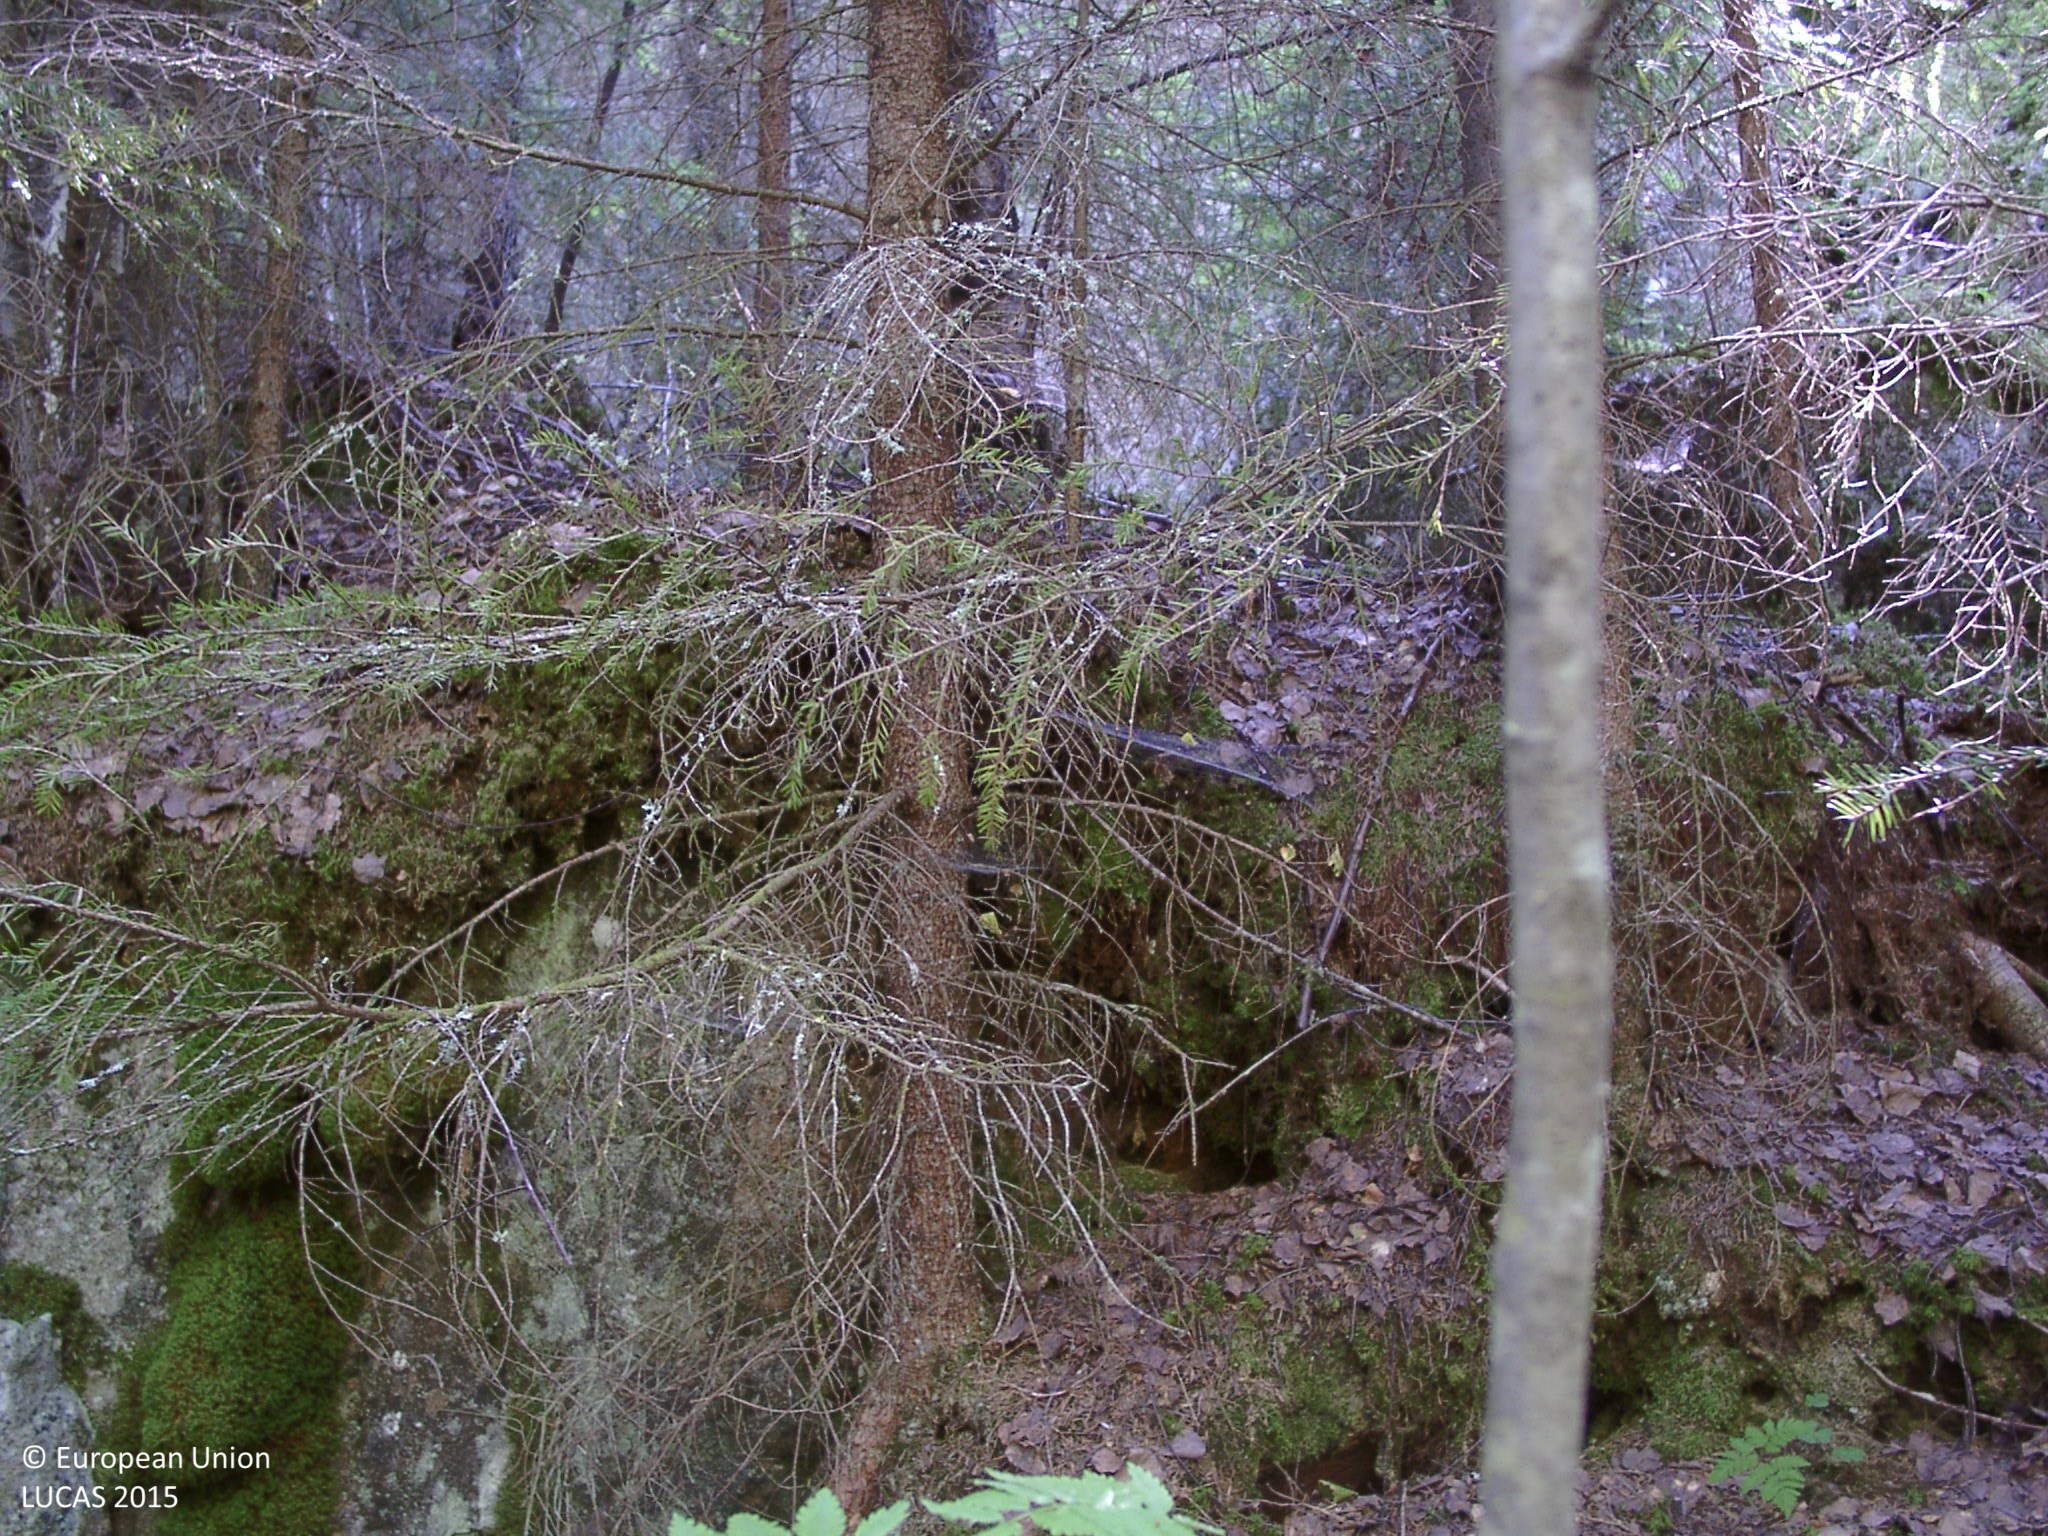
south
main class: Woodland
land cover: Spruce dominated mixed woodland
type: boreal forest
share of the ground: > 75 %
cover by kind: coniferous forest trees 50 %, broadleaved forest trees 35 %, unconsolidated bare surface 10 %, herbaceous plants 5 %
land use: Forestry
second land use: Amenities, museums, leisure
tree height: > 5 m
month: July
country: FI
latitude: 61.9283
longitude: 25.5286
